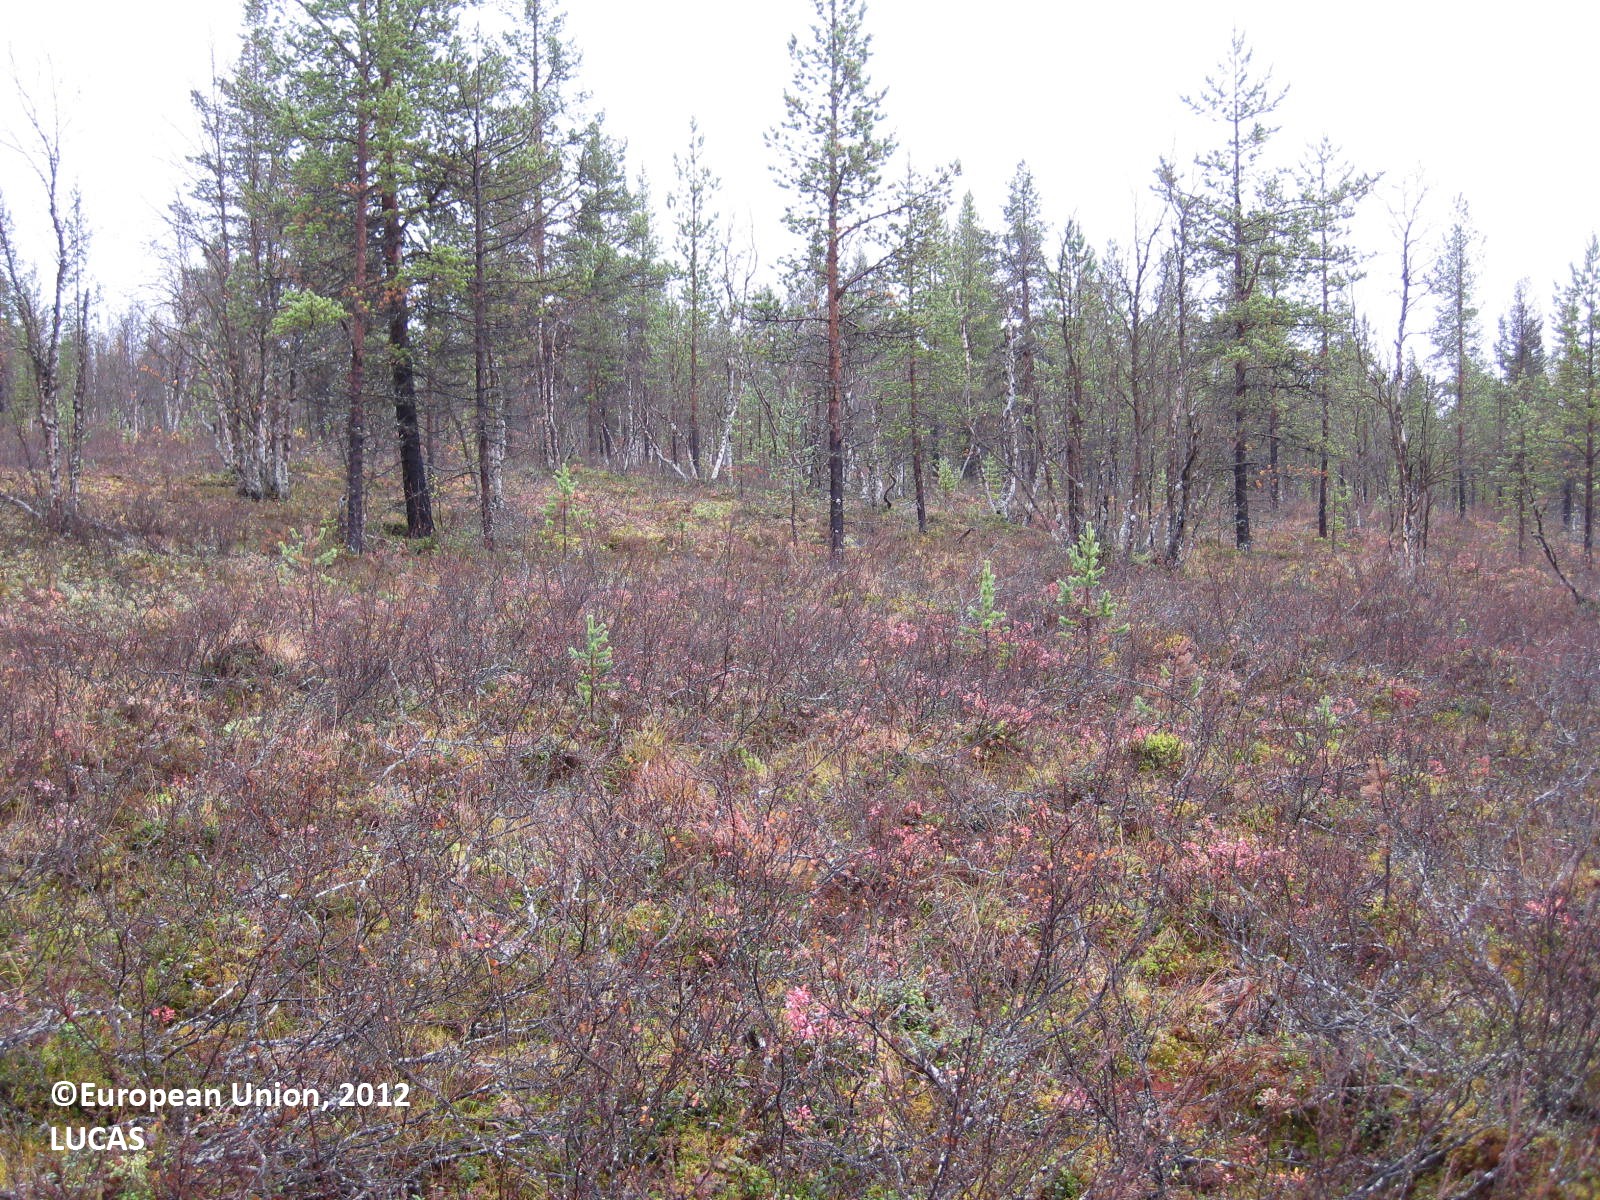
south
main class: Woodland
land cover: Pine dominated coniferous woodland
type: boreal forest
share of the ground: 25 - 50 %
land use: Forestry
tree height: > 5 m
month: September
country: FI
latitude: 68.2171
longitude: 23.3089
